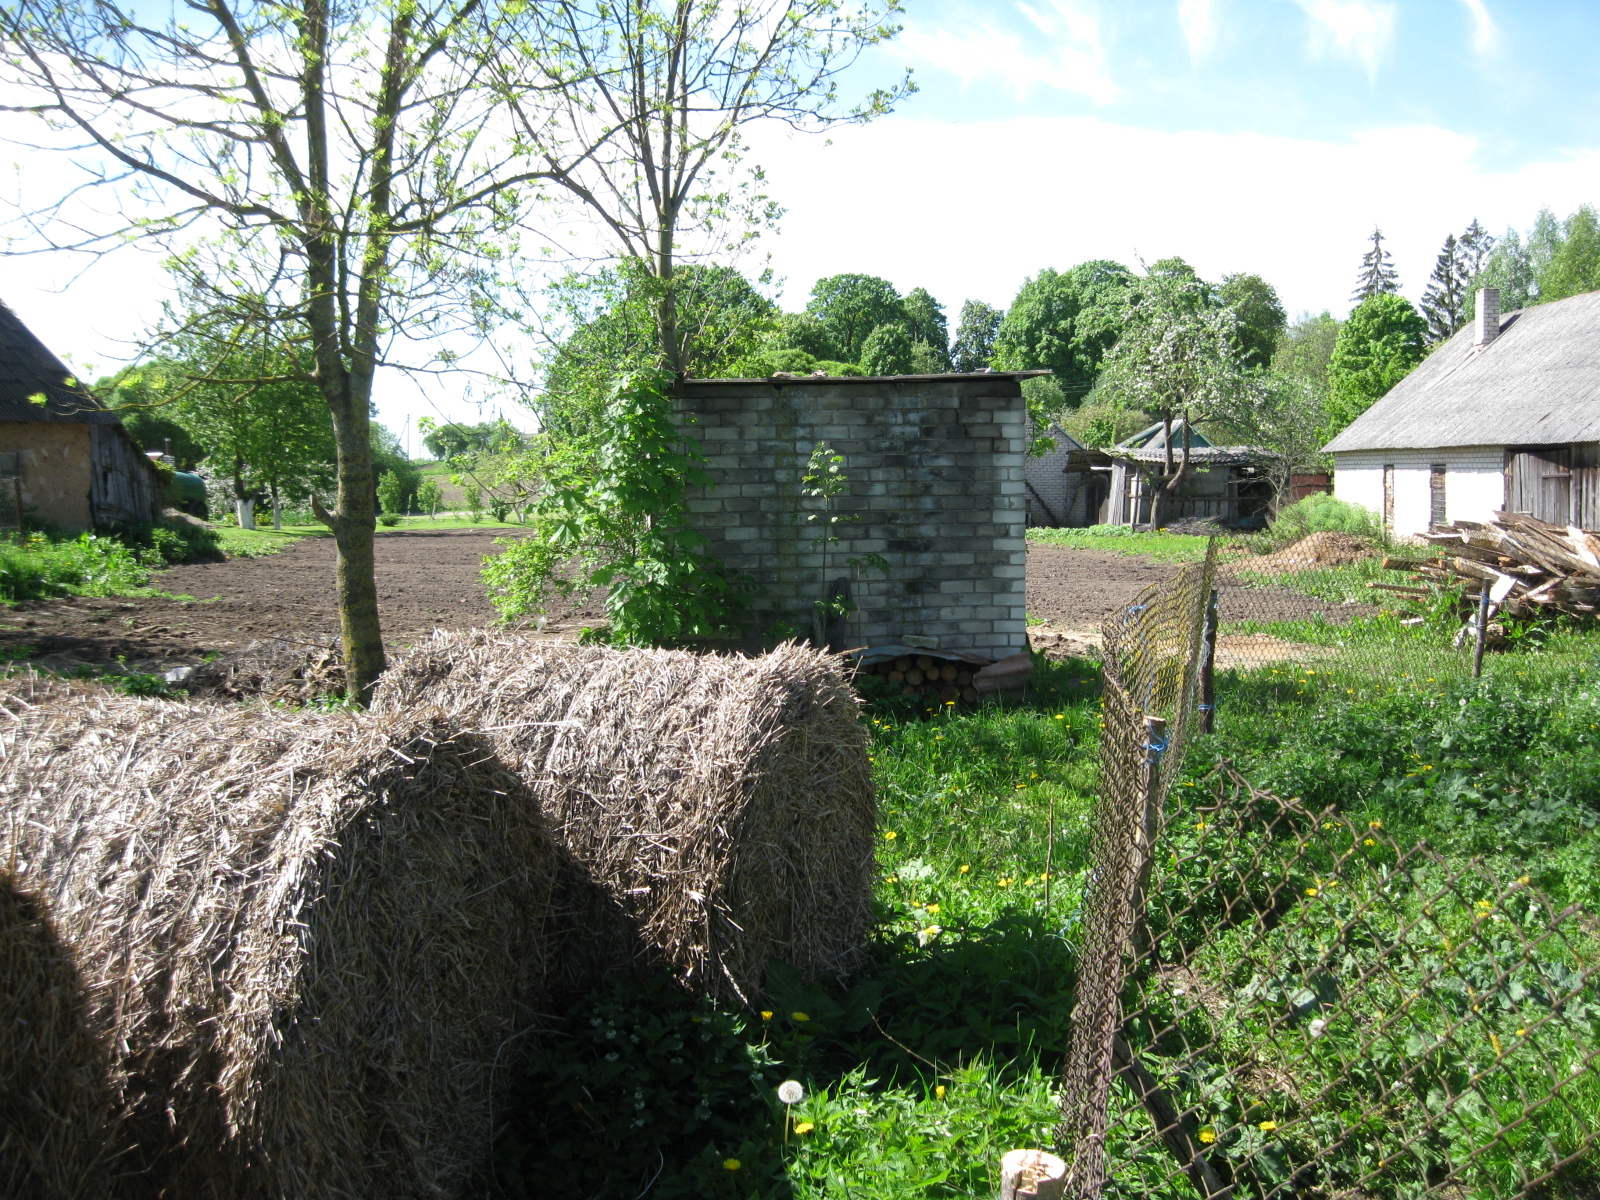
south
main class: Grassland
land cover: Spontaneously vegetated surfaces
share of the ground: 50 - 75 %
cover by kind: herbaceous plants 60 %, unconsolidated bare surface 40 %
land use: Residential
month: May
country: LT
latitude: 56.1207
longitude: 24.0660
